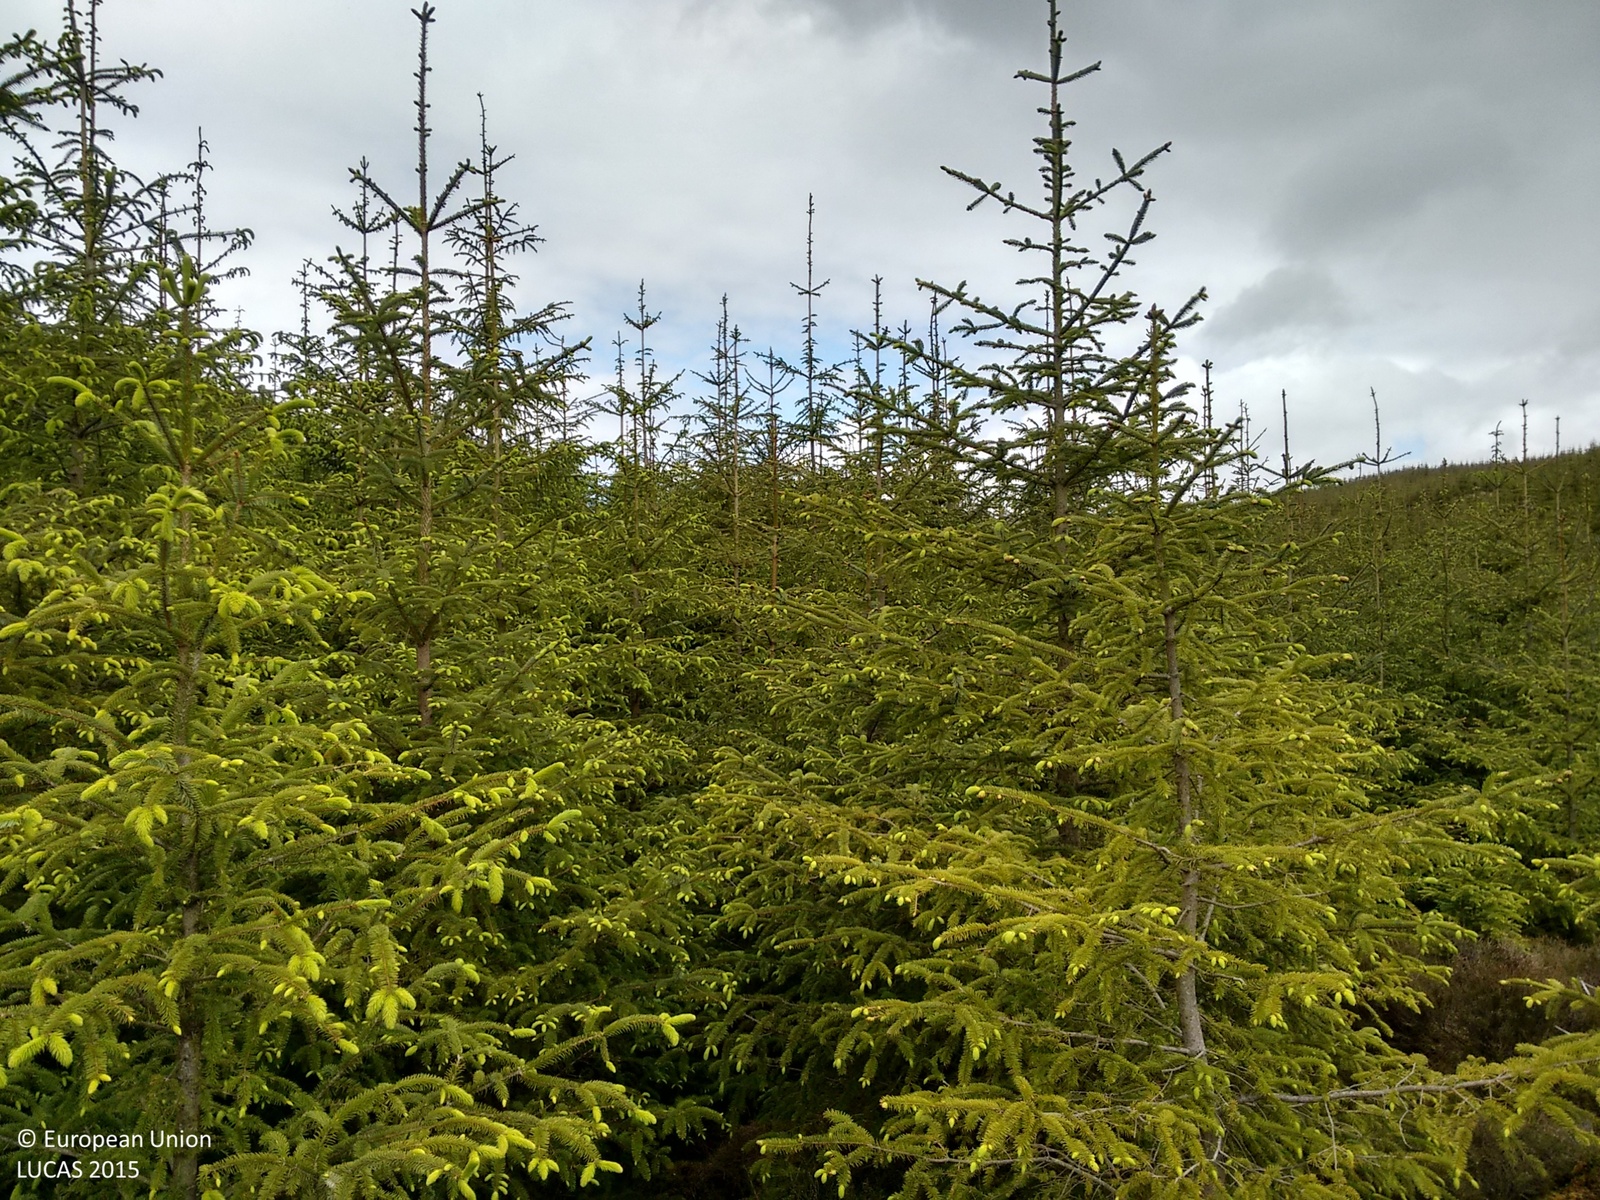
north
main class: Woodland
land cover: Spruce dominated coniferous woodland
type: exotic forest
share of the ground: > 75 %
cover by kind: coniferous forest trees 100 %
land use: Forestry
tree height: > 5 m
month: June
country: GB
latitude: 56.1205
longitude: -5.4825
